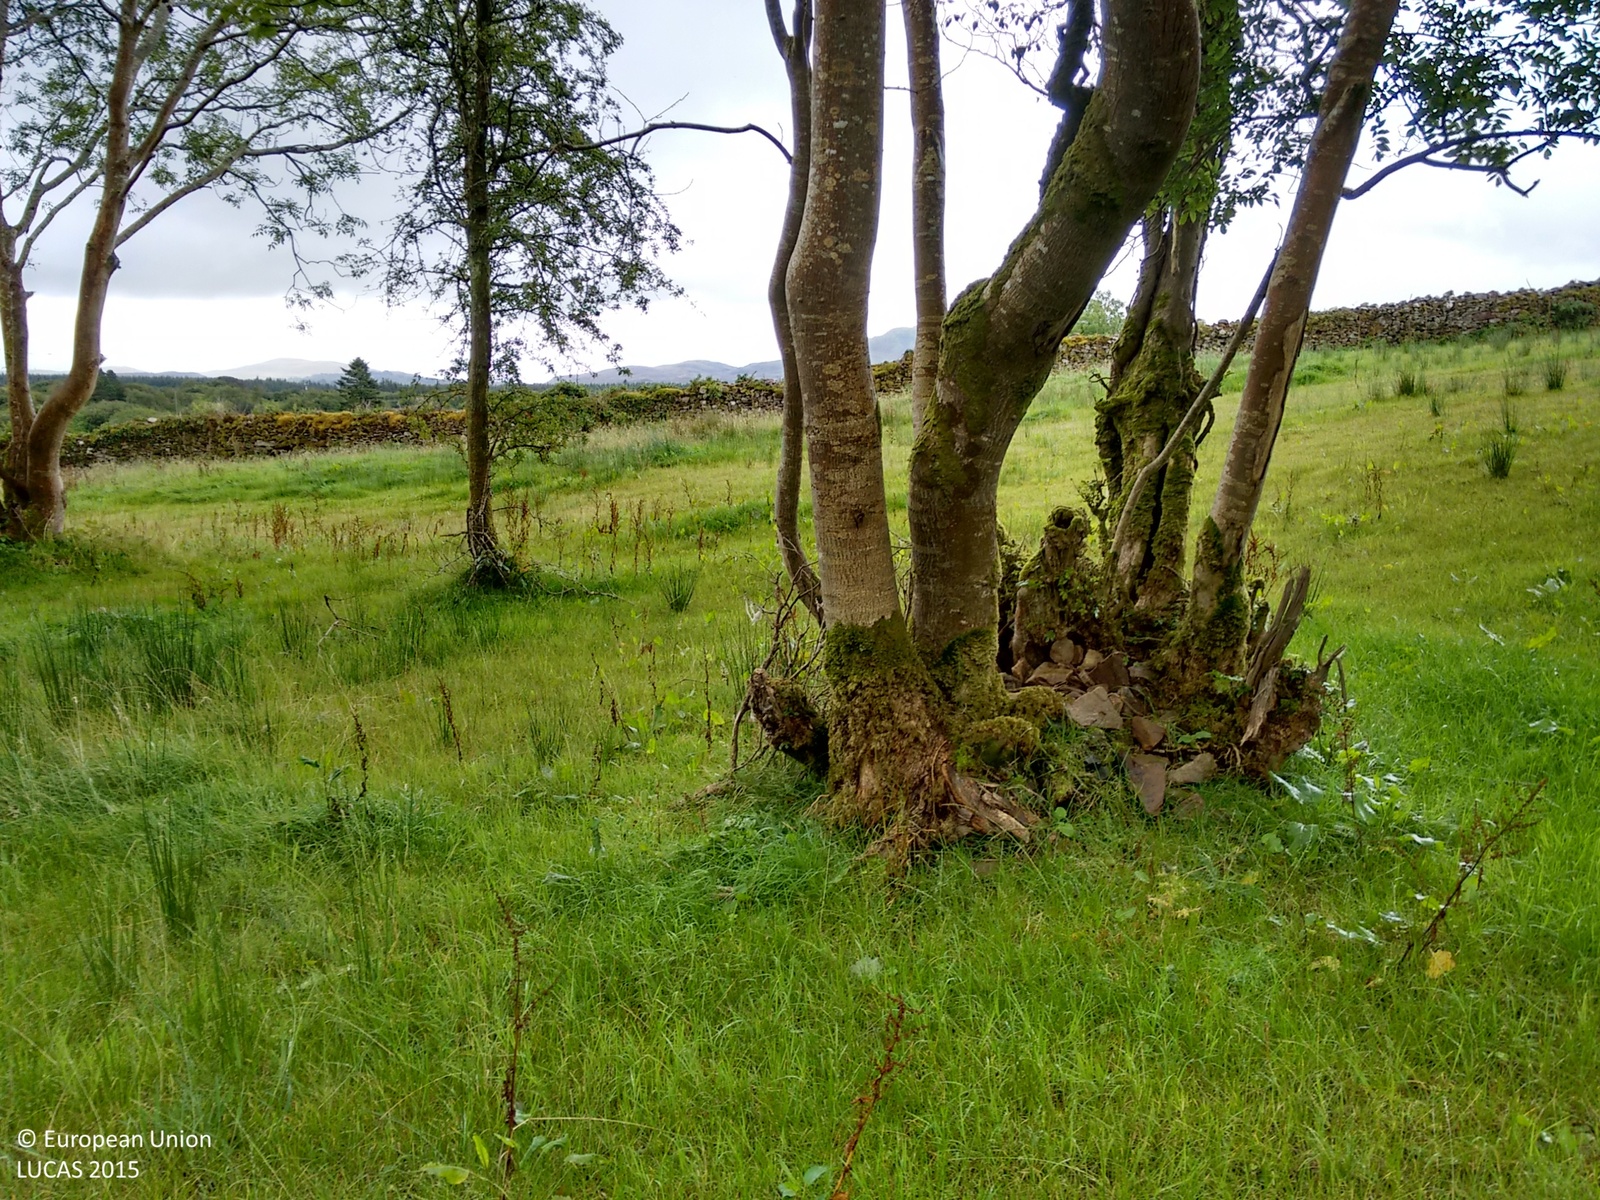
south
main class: Woodland
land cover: Broadleaved woodland
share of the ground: > 75 %
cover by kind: broadleaved forest trees 75 %, herbaceous plants 25 %
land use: Agriculture (excluding fallow land and kitchen gardens)
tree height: < 5 m
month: September
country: IE
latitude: 54.0159
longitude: -9.2844
